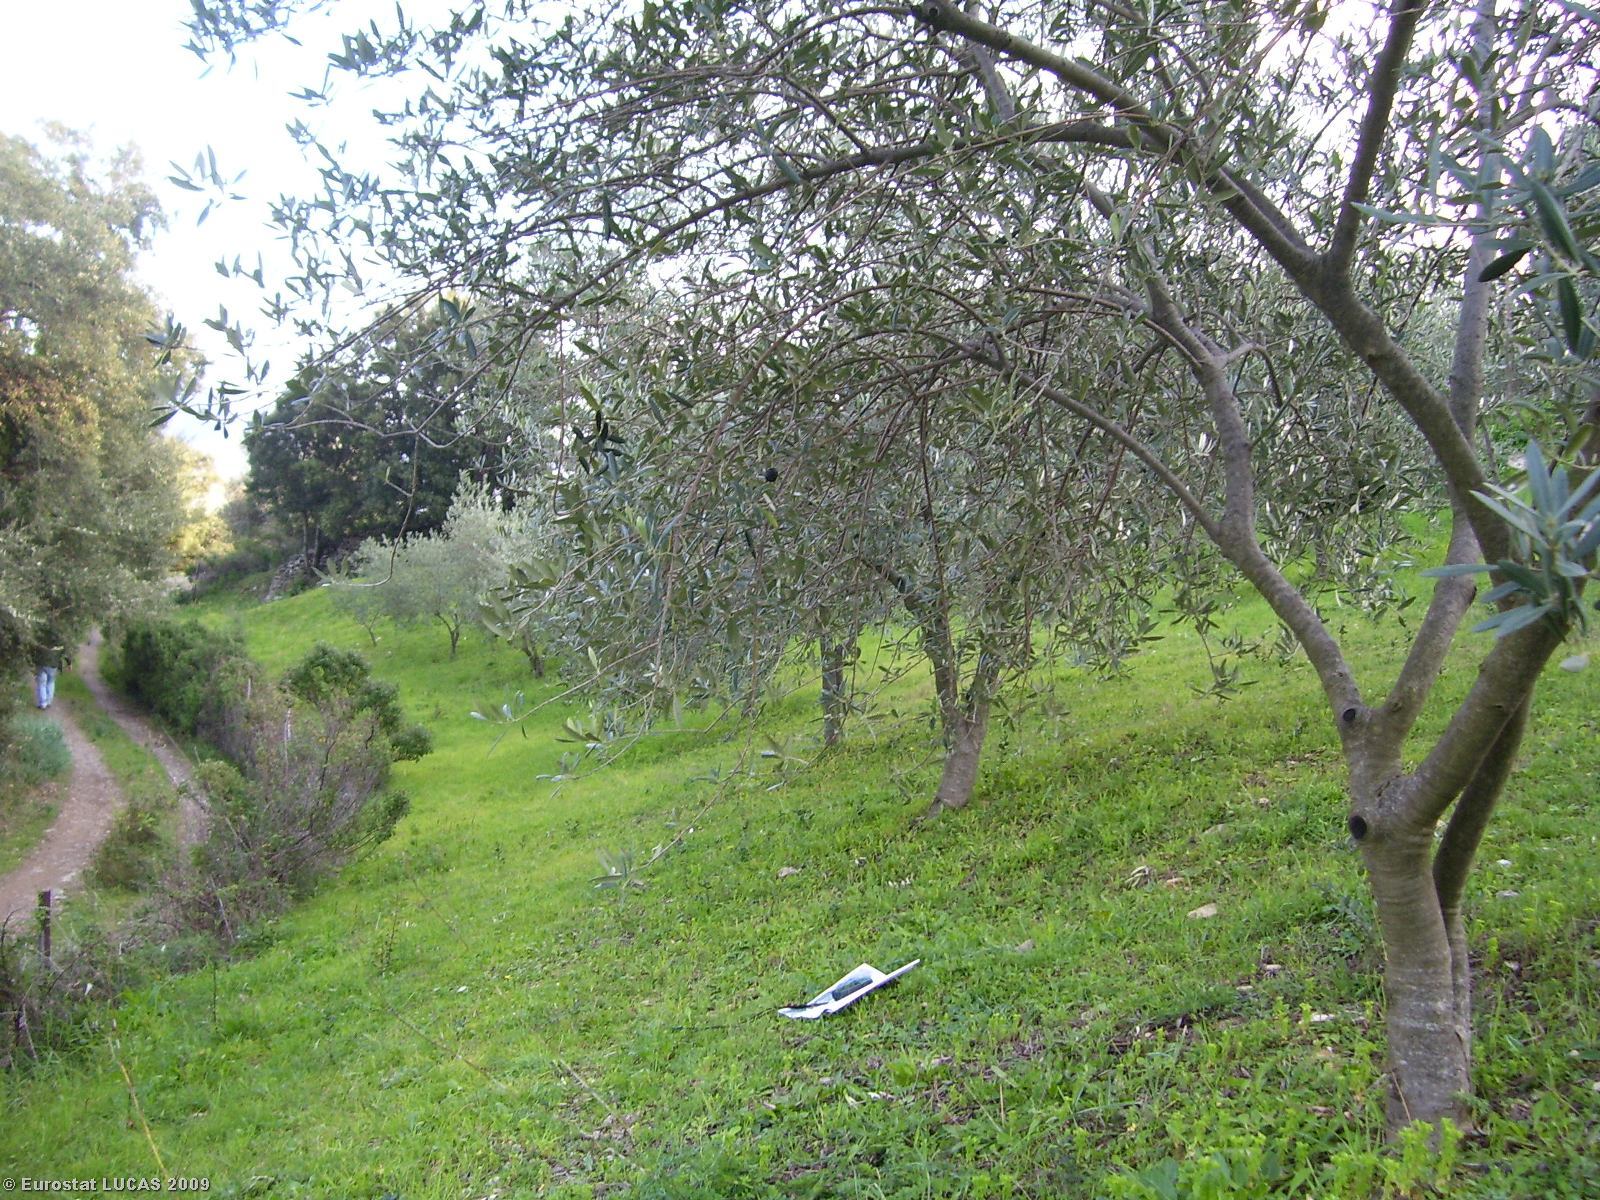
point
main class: Cropland
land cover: Olive groves
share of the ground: 50 - 75 %
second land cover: Grassland with sparse tree/shrub cover
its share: > 75 %
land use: Agriculture (excluding fallow land and kitchen gardens)
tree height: > 5 m
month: July
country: IT
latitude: 39.7050
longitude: 9.5709
